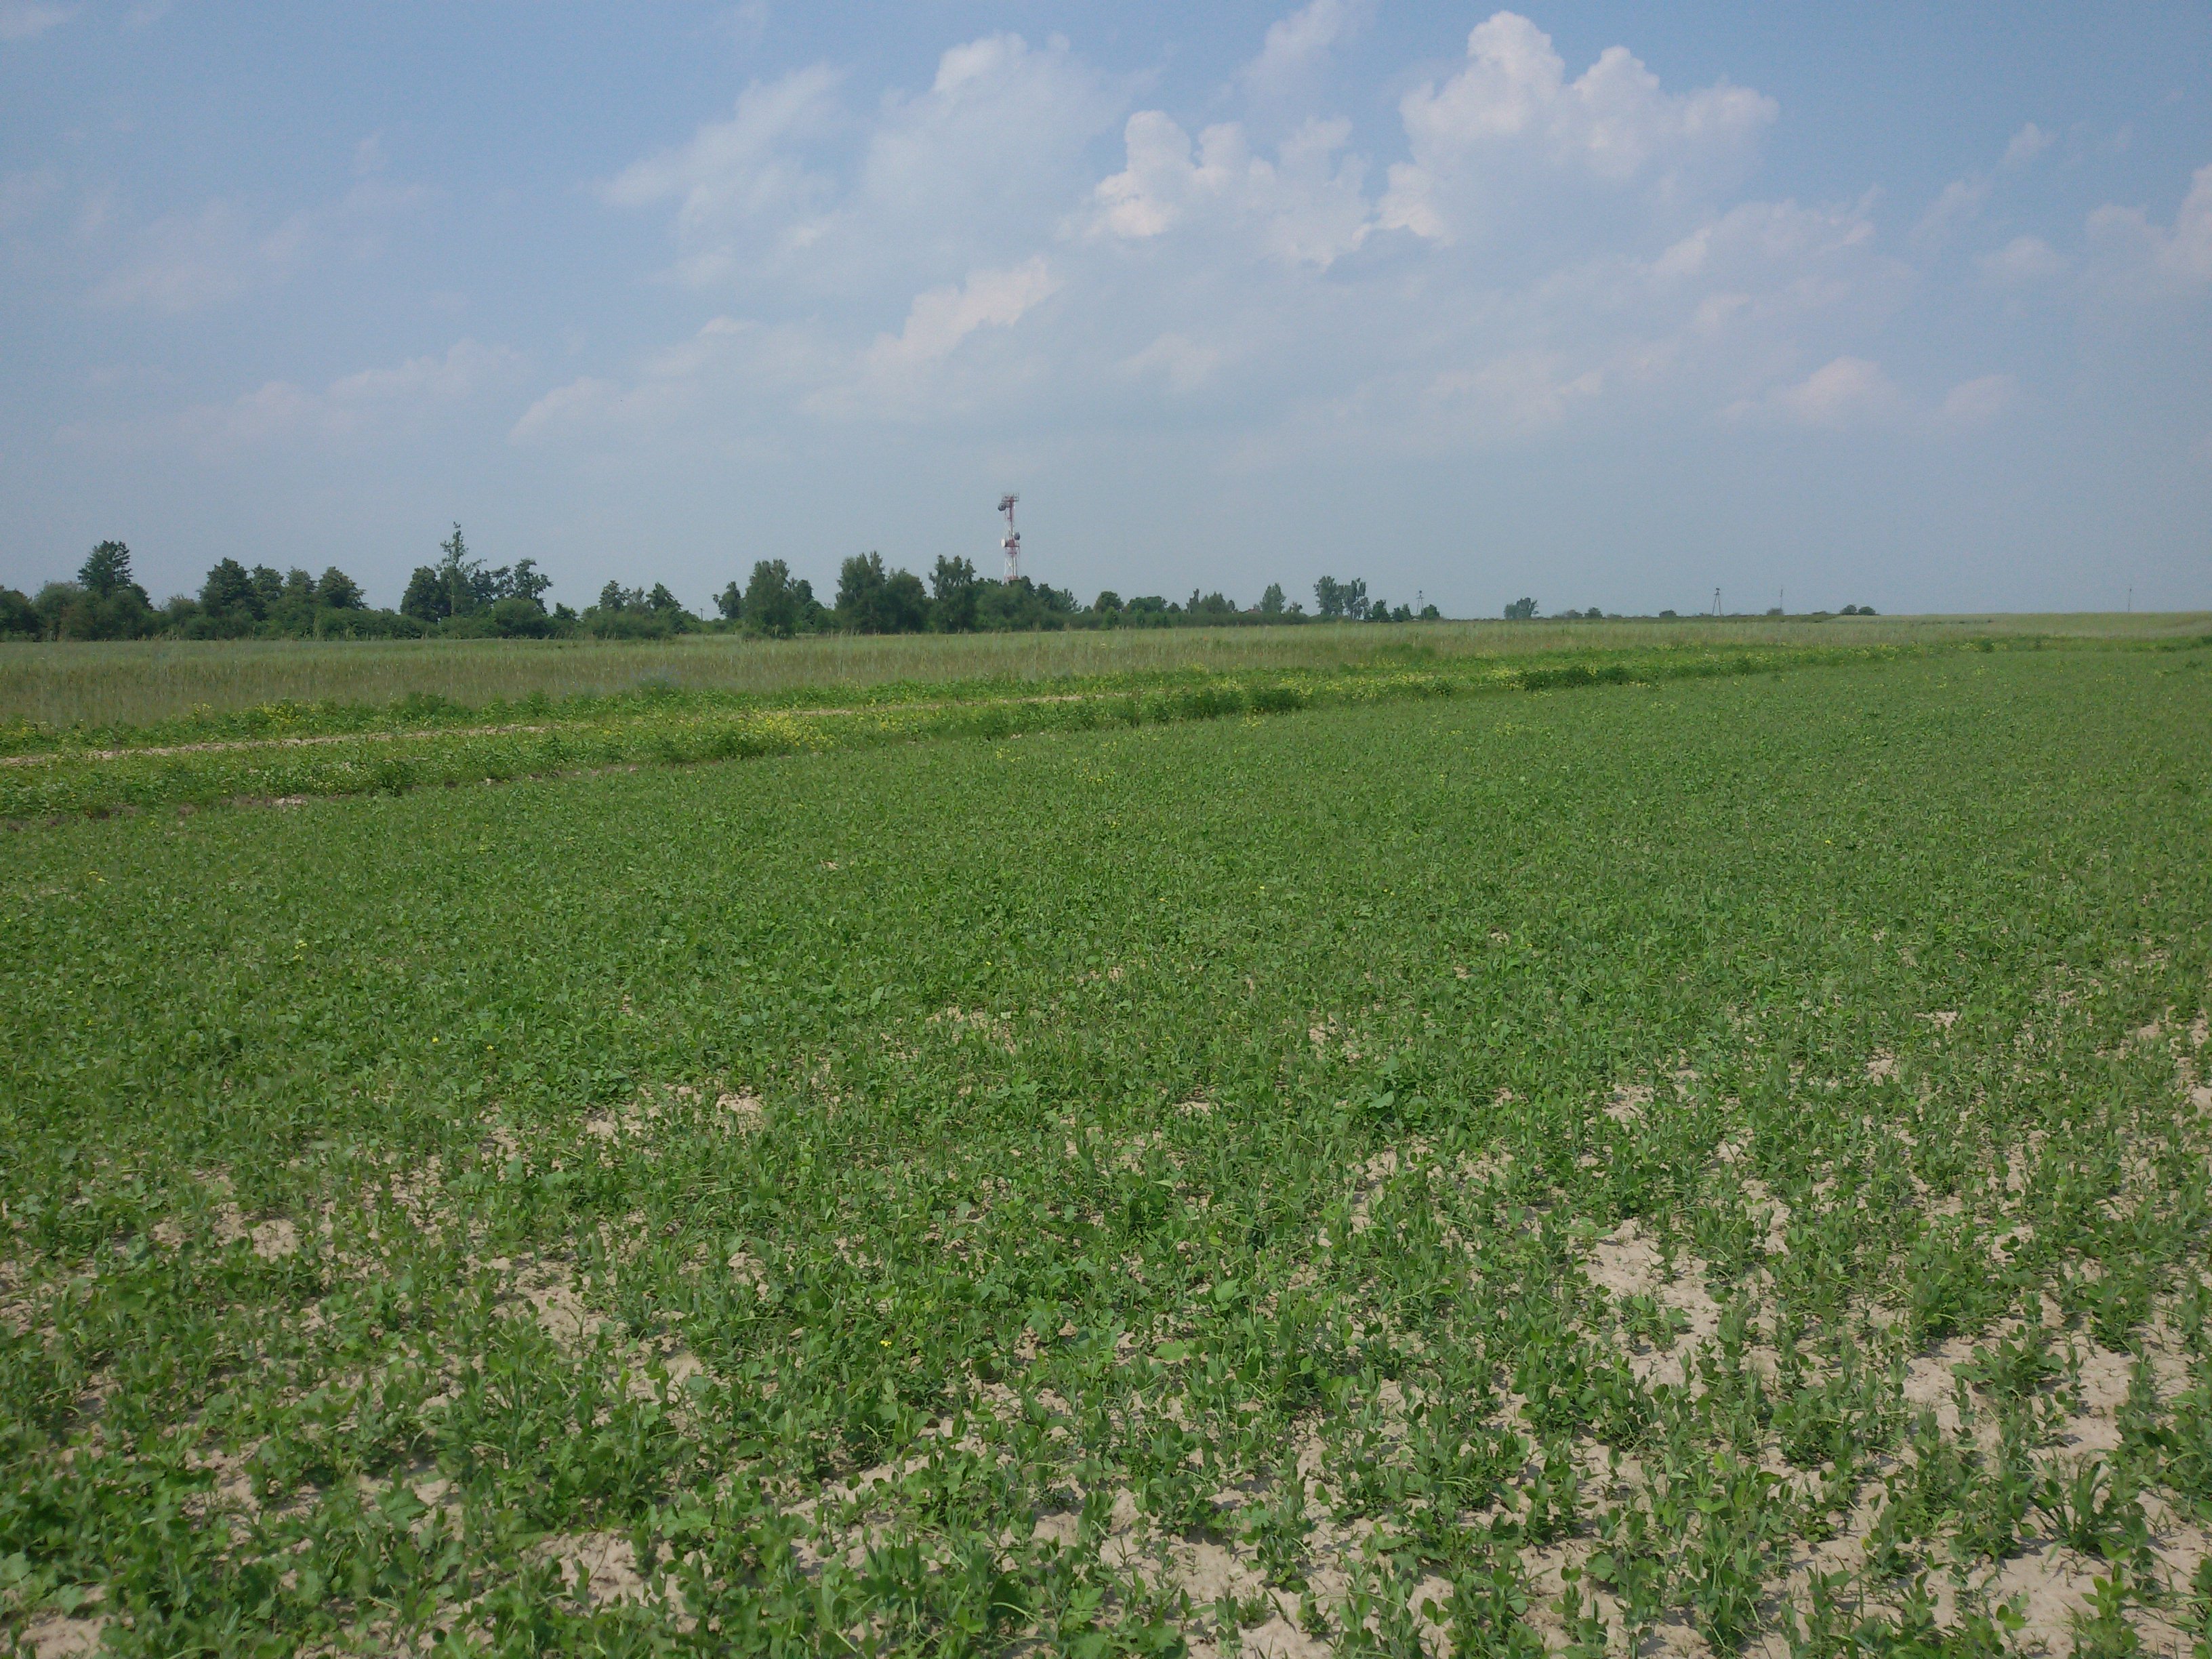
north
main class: Cropland
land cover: Other leguminous and mixtures for fodder
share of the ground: > 75 %
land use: Agriculture (excluding fallow land and kitchen gardens)
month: June
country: PL
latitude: 51.1088
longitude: 21.4918
